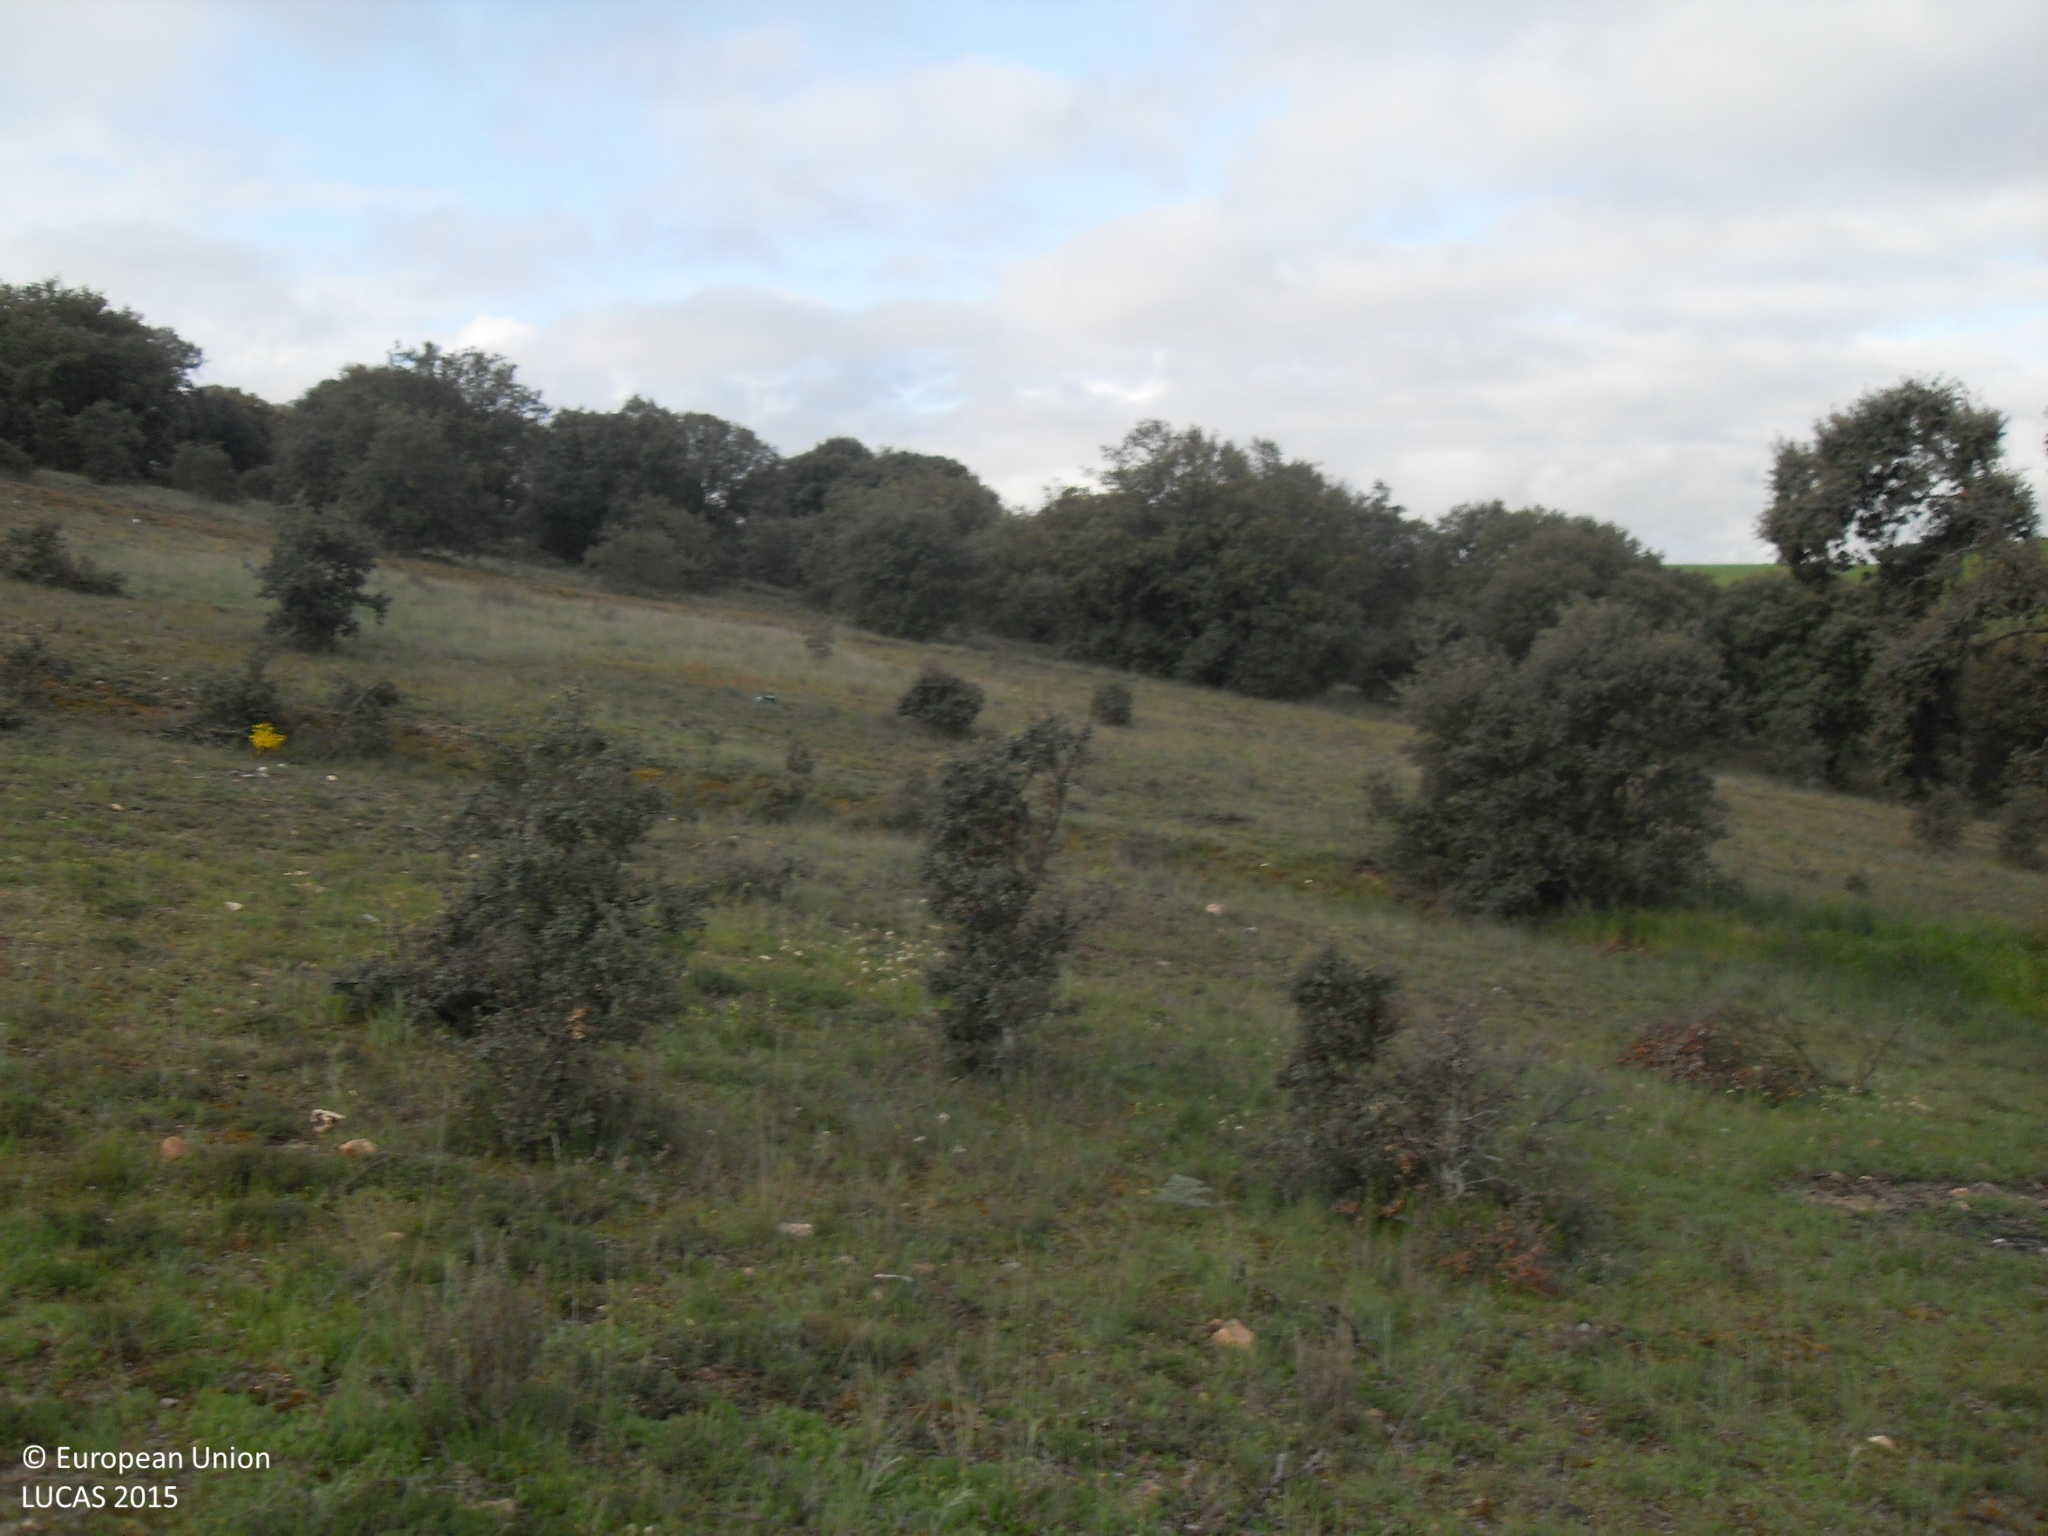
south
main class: Woodland
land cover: Broadleaved woodland
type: broadleaved evergreen forest
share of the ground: 10 - 25 %
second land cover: Grassland without tree/shrub cover
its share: > 75 %
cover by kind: herbaceous plants 85 %, broadleaved forest trees 15 %
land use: Forestry
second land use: Agriculture (excluding fallow land and kitchen gardens)
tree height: > 5 m
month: May
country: ES
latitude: 40.8122
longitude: -5.1327
